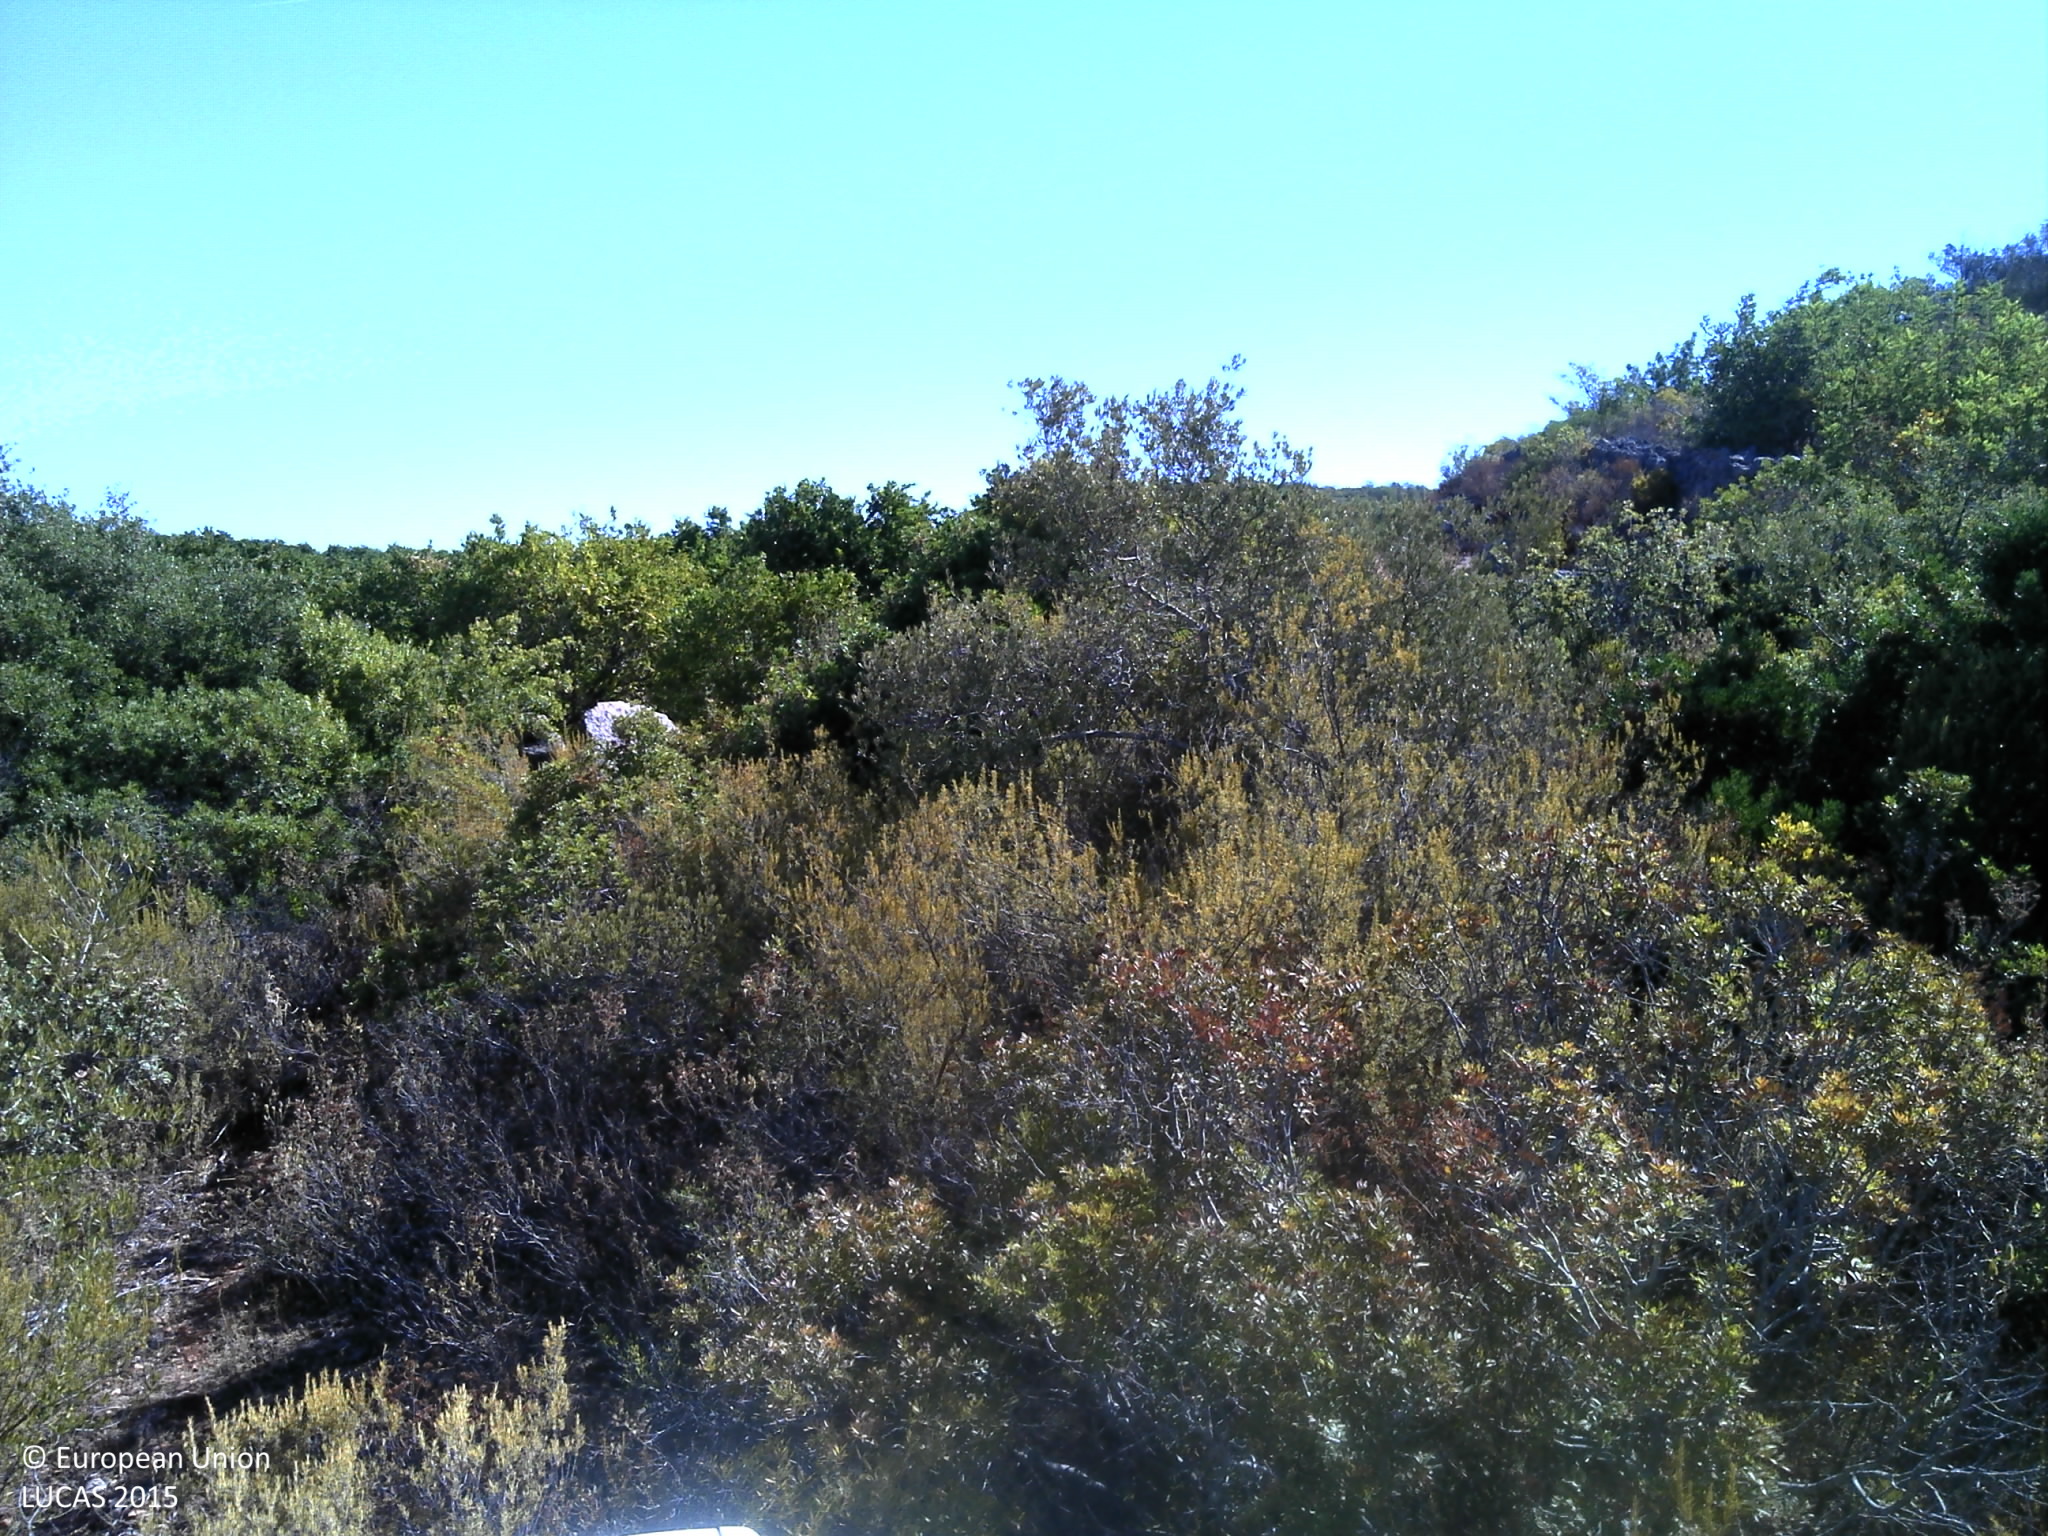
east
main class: Shrubland
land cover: Shrubland without tree cover
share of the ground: 50 - 75 %
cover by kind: shrubs 70 %, unconsolidated bare surface 30 %
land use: Semi-natural and natural areas not in use
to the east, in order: Shrubland without tree cover; Tracks; Shrubland without tree cover; Tracks; Shrubland without tree cover
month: September
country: PT
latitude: 37.2214
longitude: -8.1741
